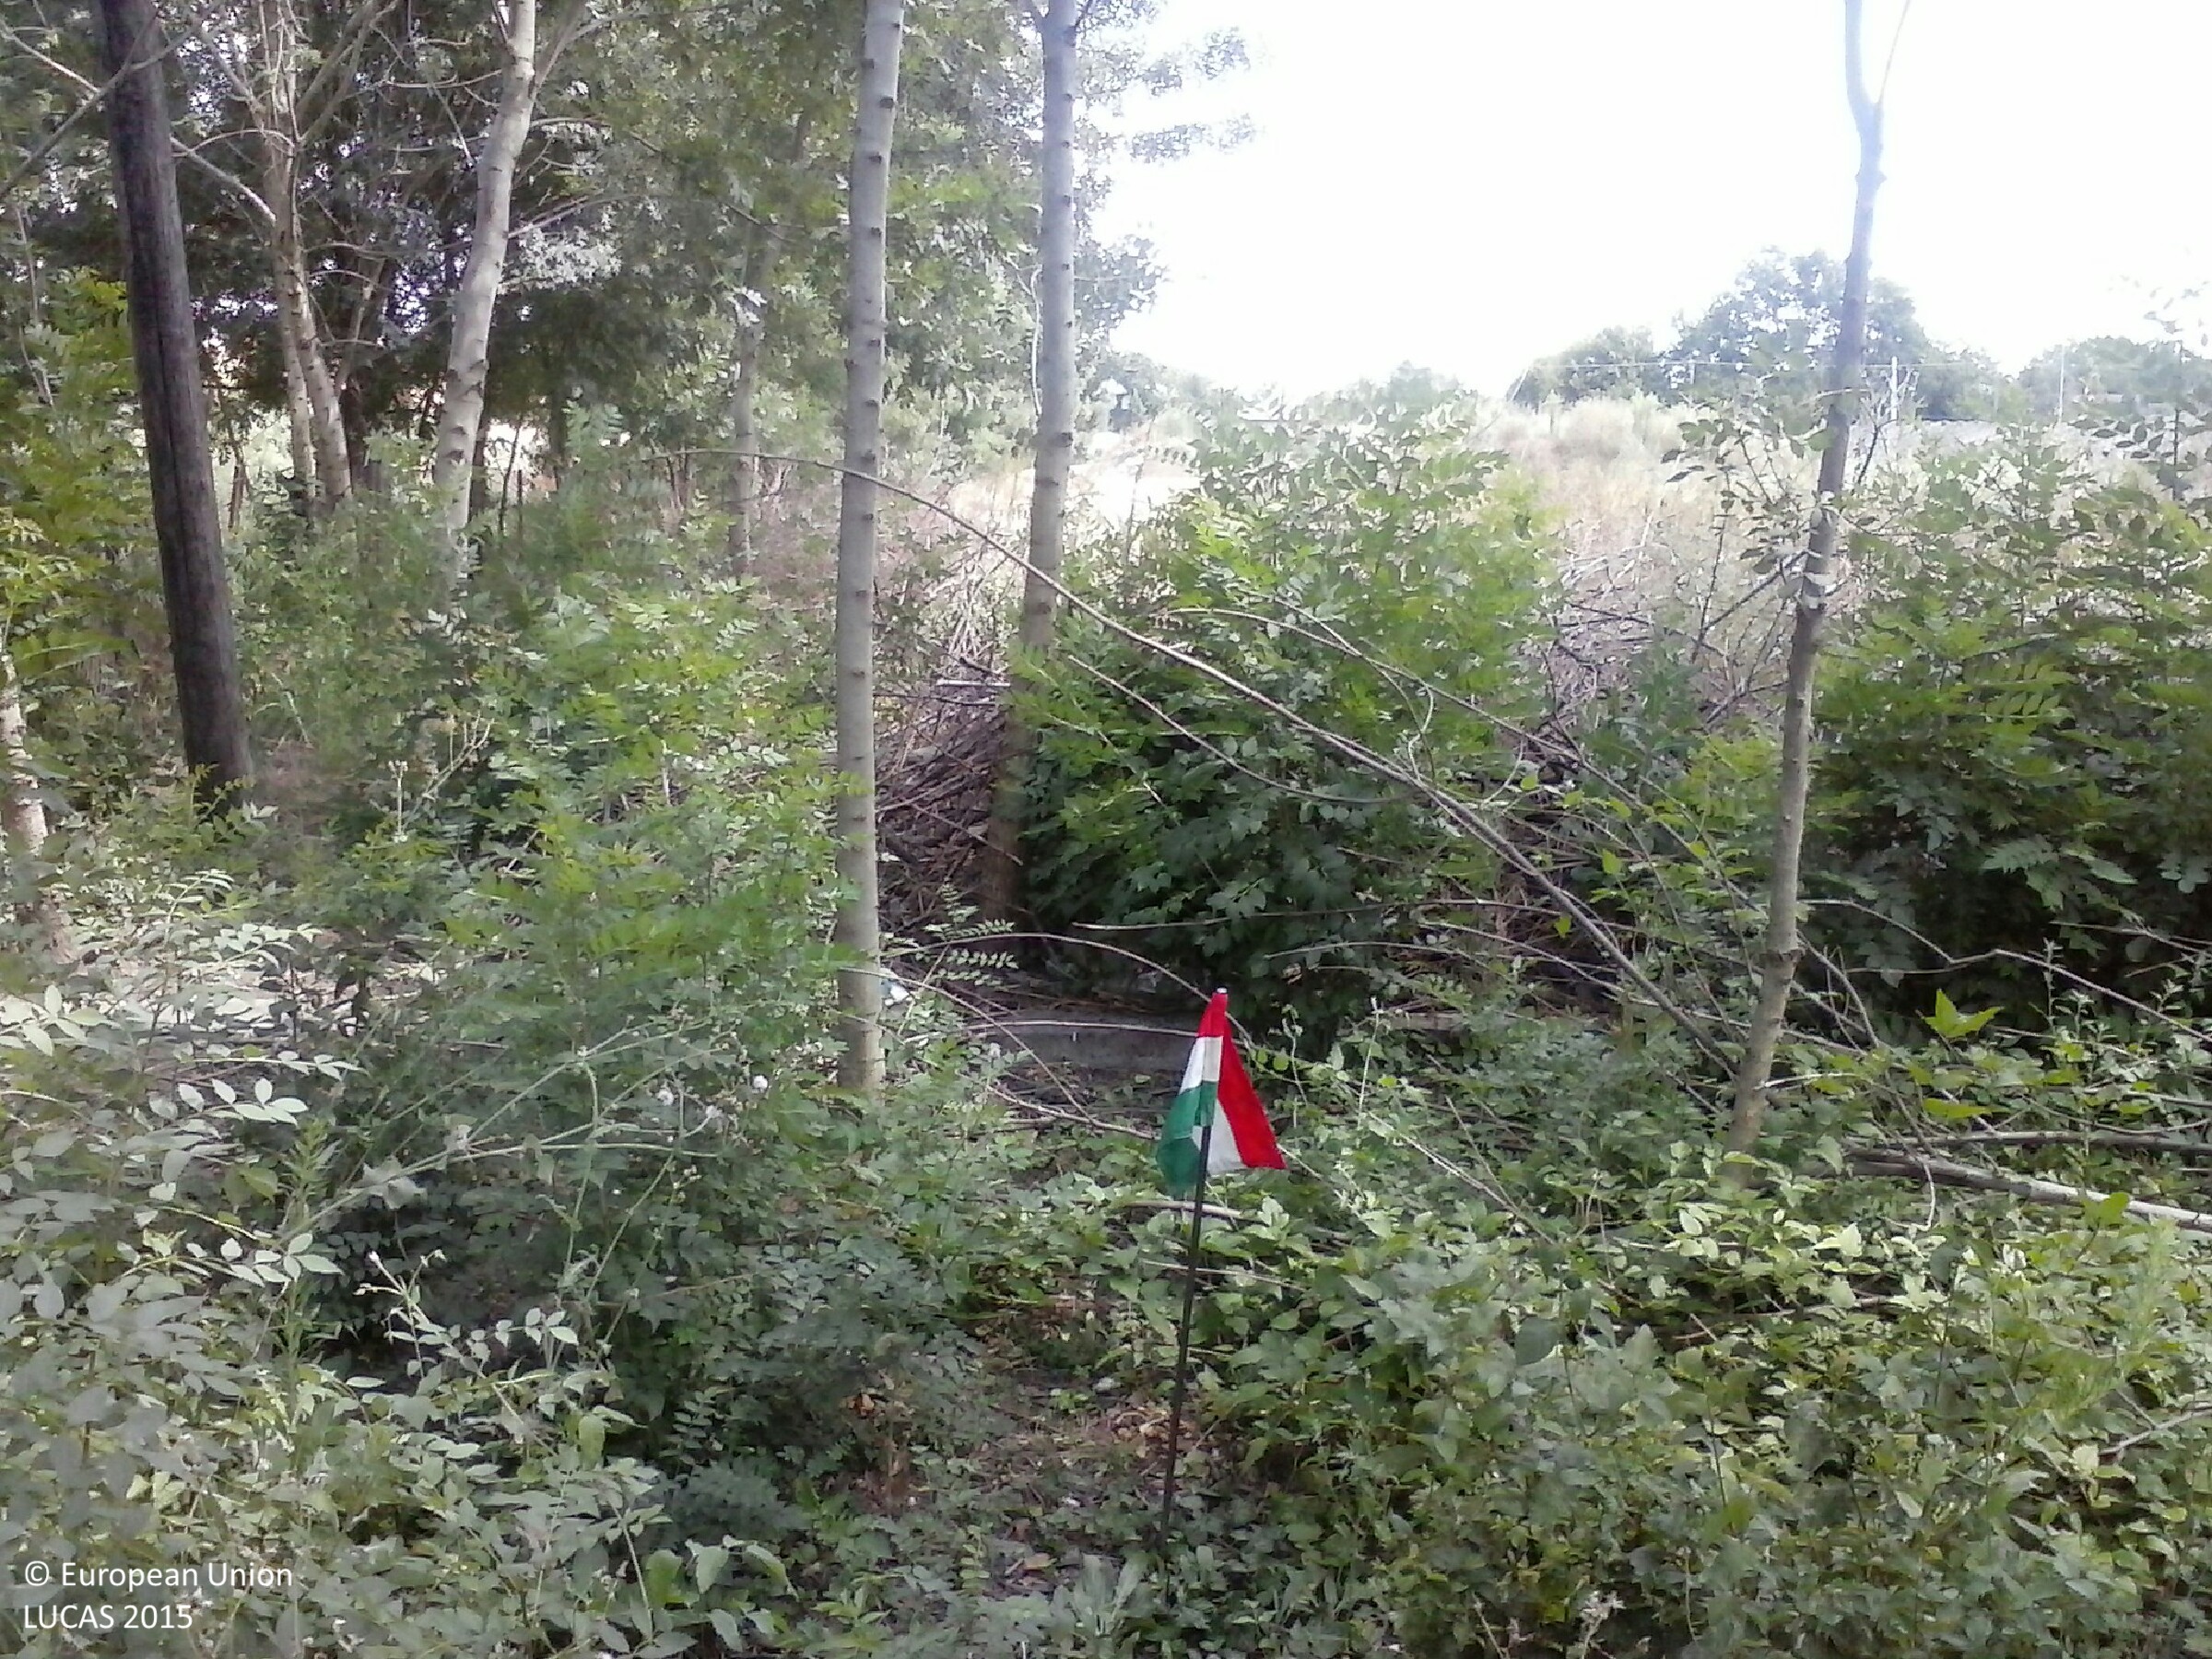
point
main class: Woodland
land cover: Broadleaved woodland
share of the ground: > 75 %
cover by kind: shrubs 80 %, broadleaved forest trees 15 %, herbaceous plants 5 %
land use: Forestry
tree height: < 5 m
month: July
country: HU
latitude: 46.4292
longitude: 20.3442
